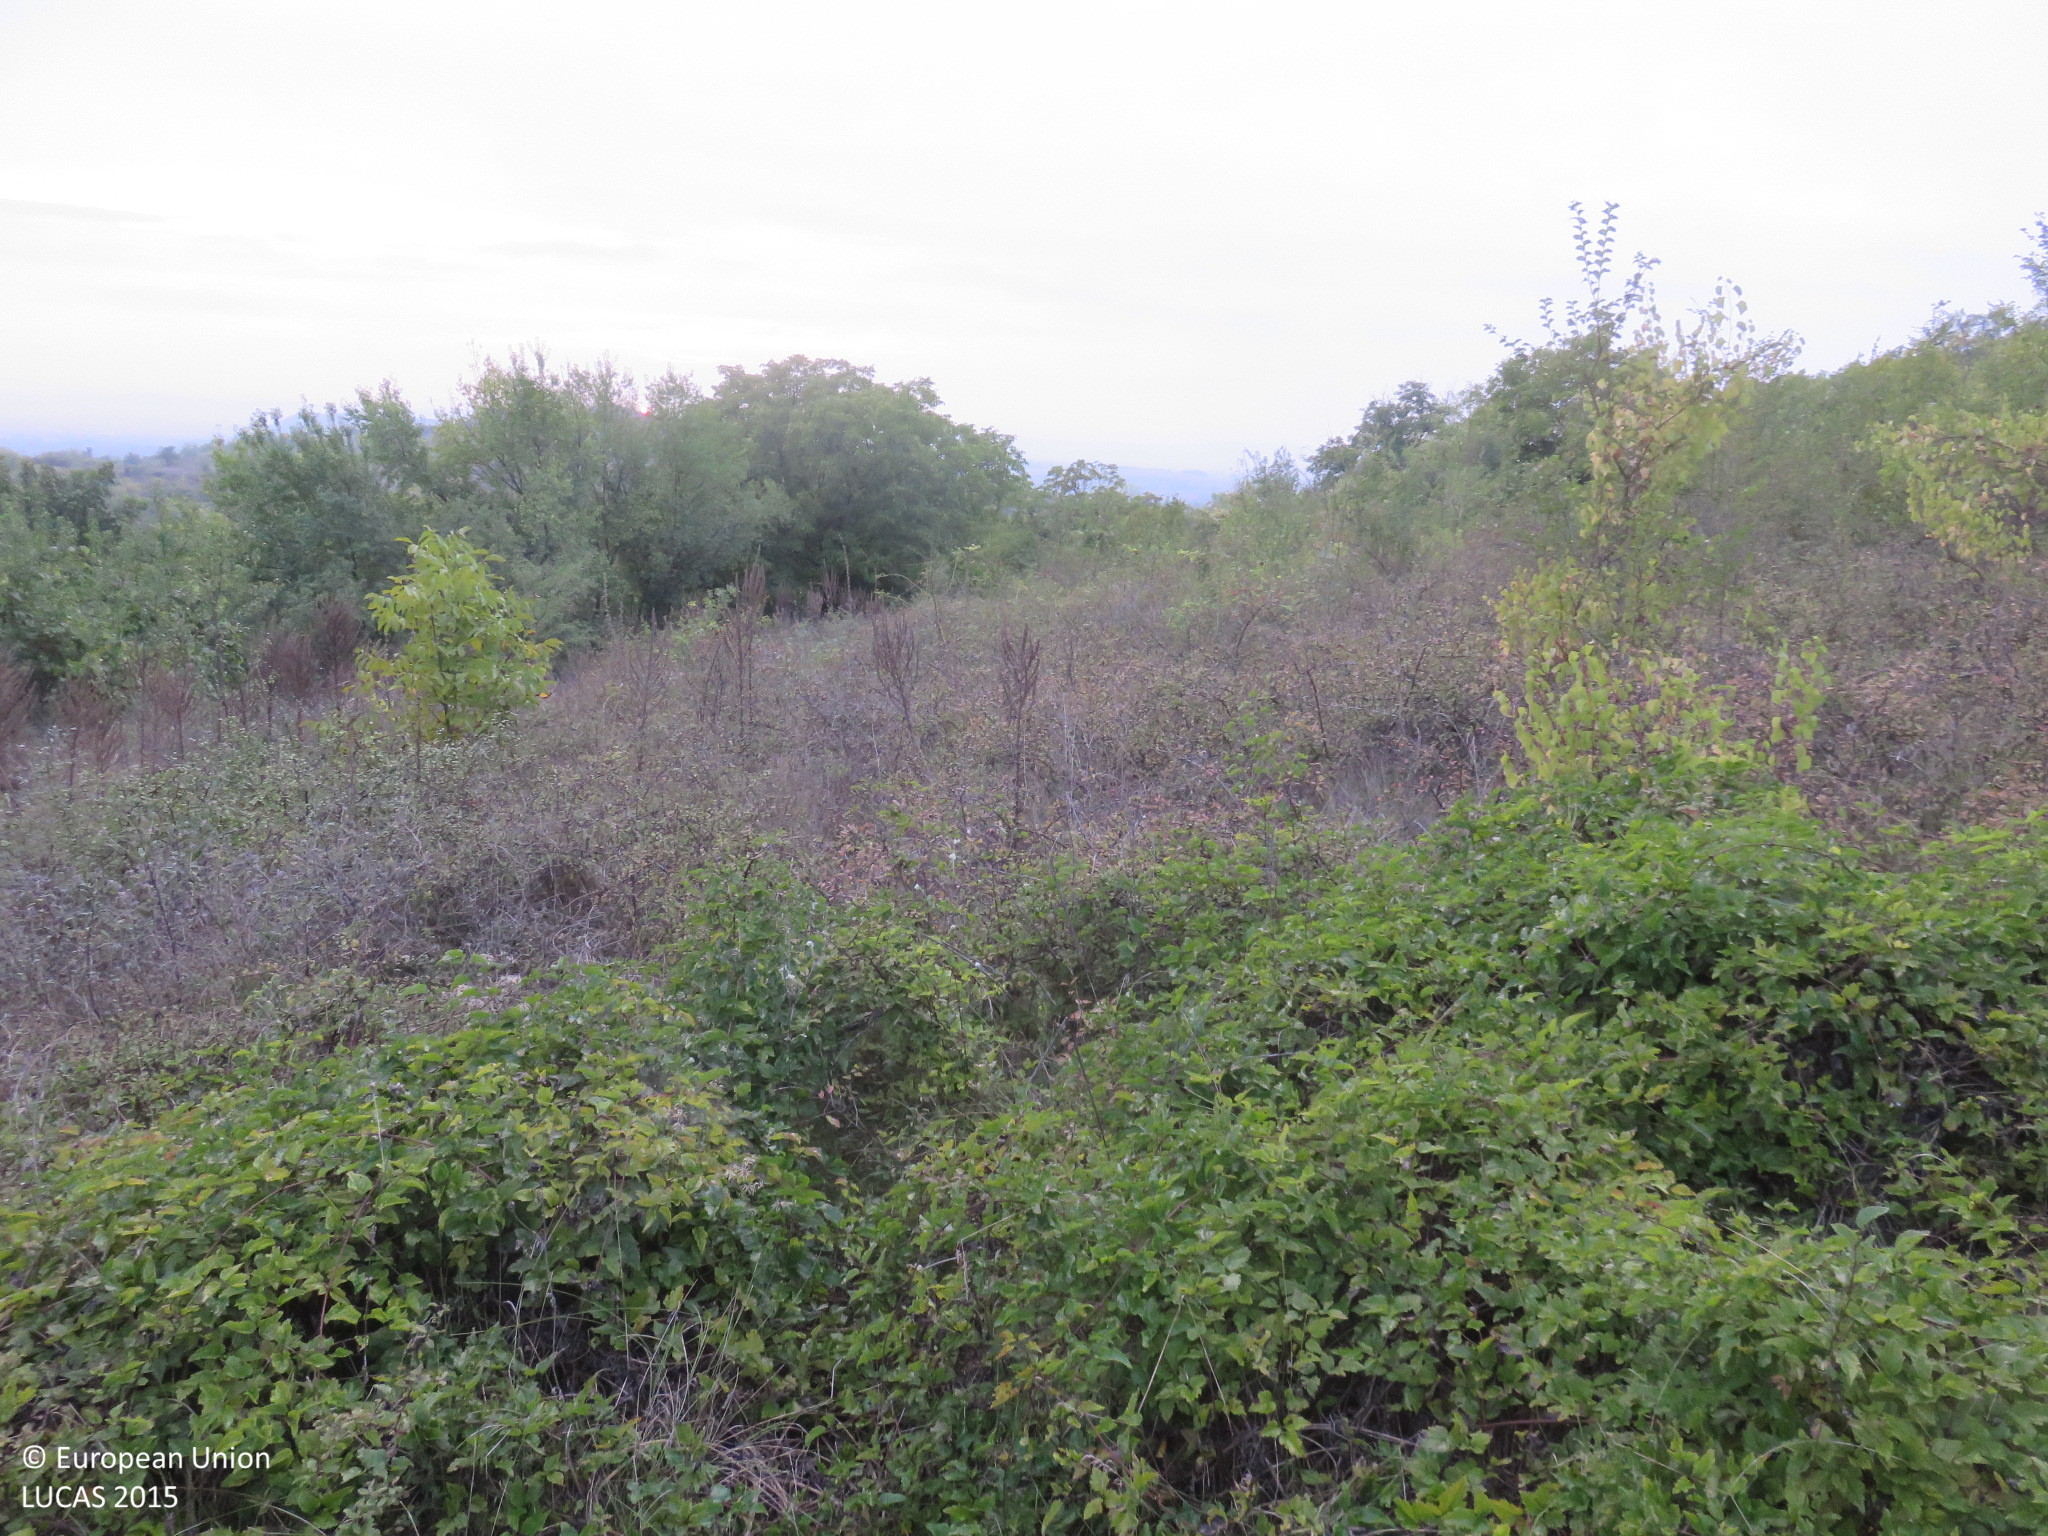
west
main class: Shrubland
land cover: Shrubland with sparse tree cover
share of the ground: > 75 %
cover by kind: shrubs 95 %, broadleaved forest trees 5 %
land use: Abandoned areas
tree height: < 5 m
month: September
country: BG
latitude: 43.1882
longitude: 24.8173
